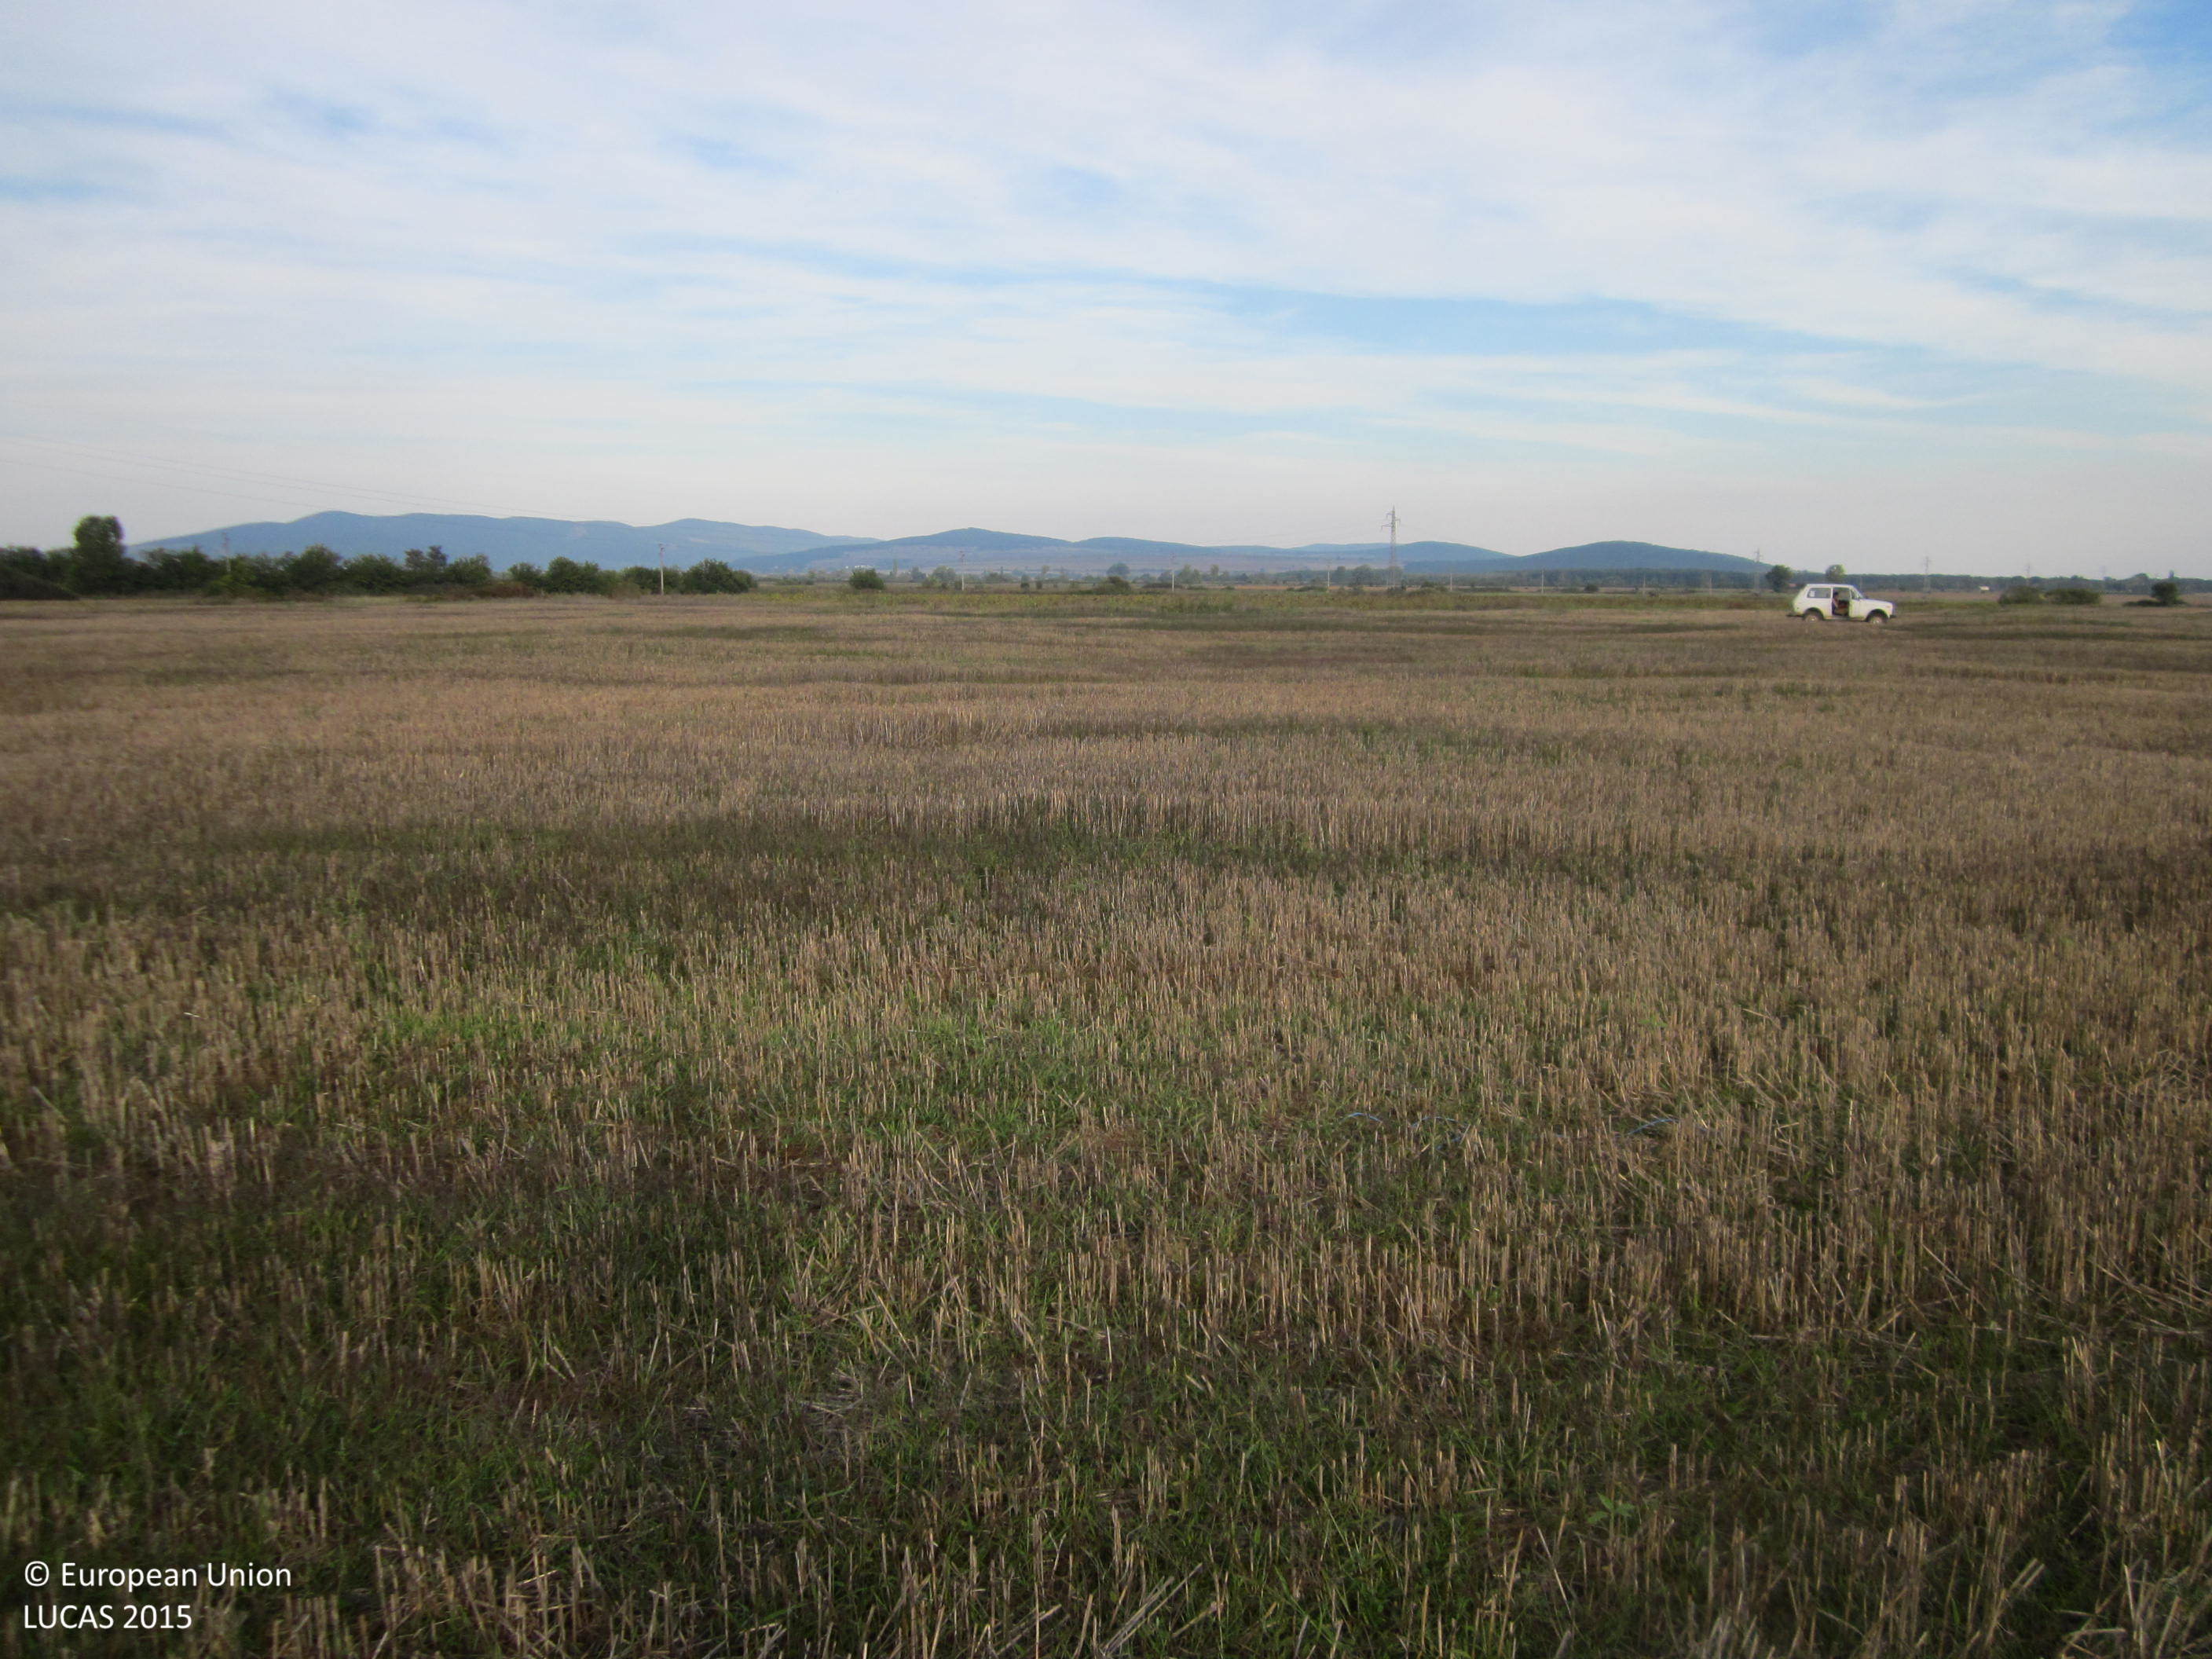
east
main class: Cropland
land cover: Common wheat
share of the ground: 50 - 75 %
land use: Agriculture (excluding fallow land and kitchen gardens)
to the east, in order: Common wheat; Tracks; Common wheat; Tracks; Sunflower
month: October
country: BG
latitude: 42.7475
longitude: 26.8033
